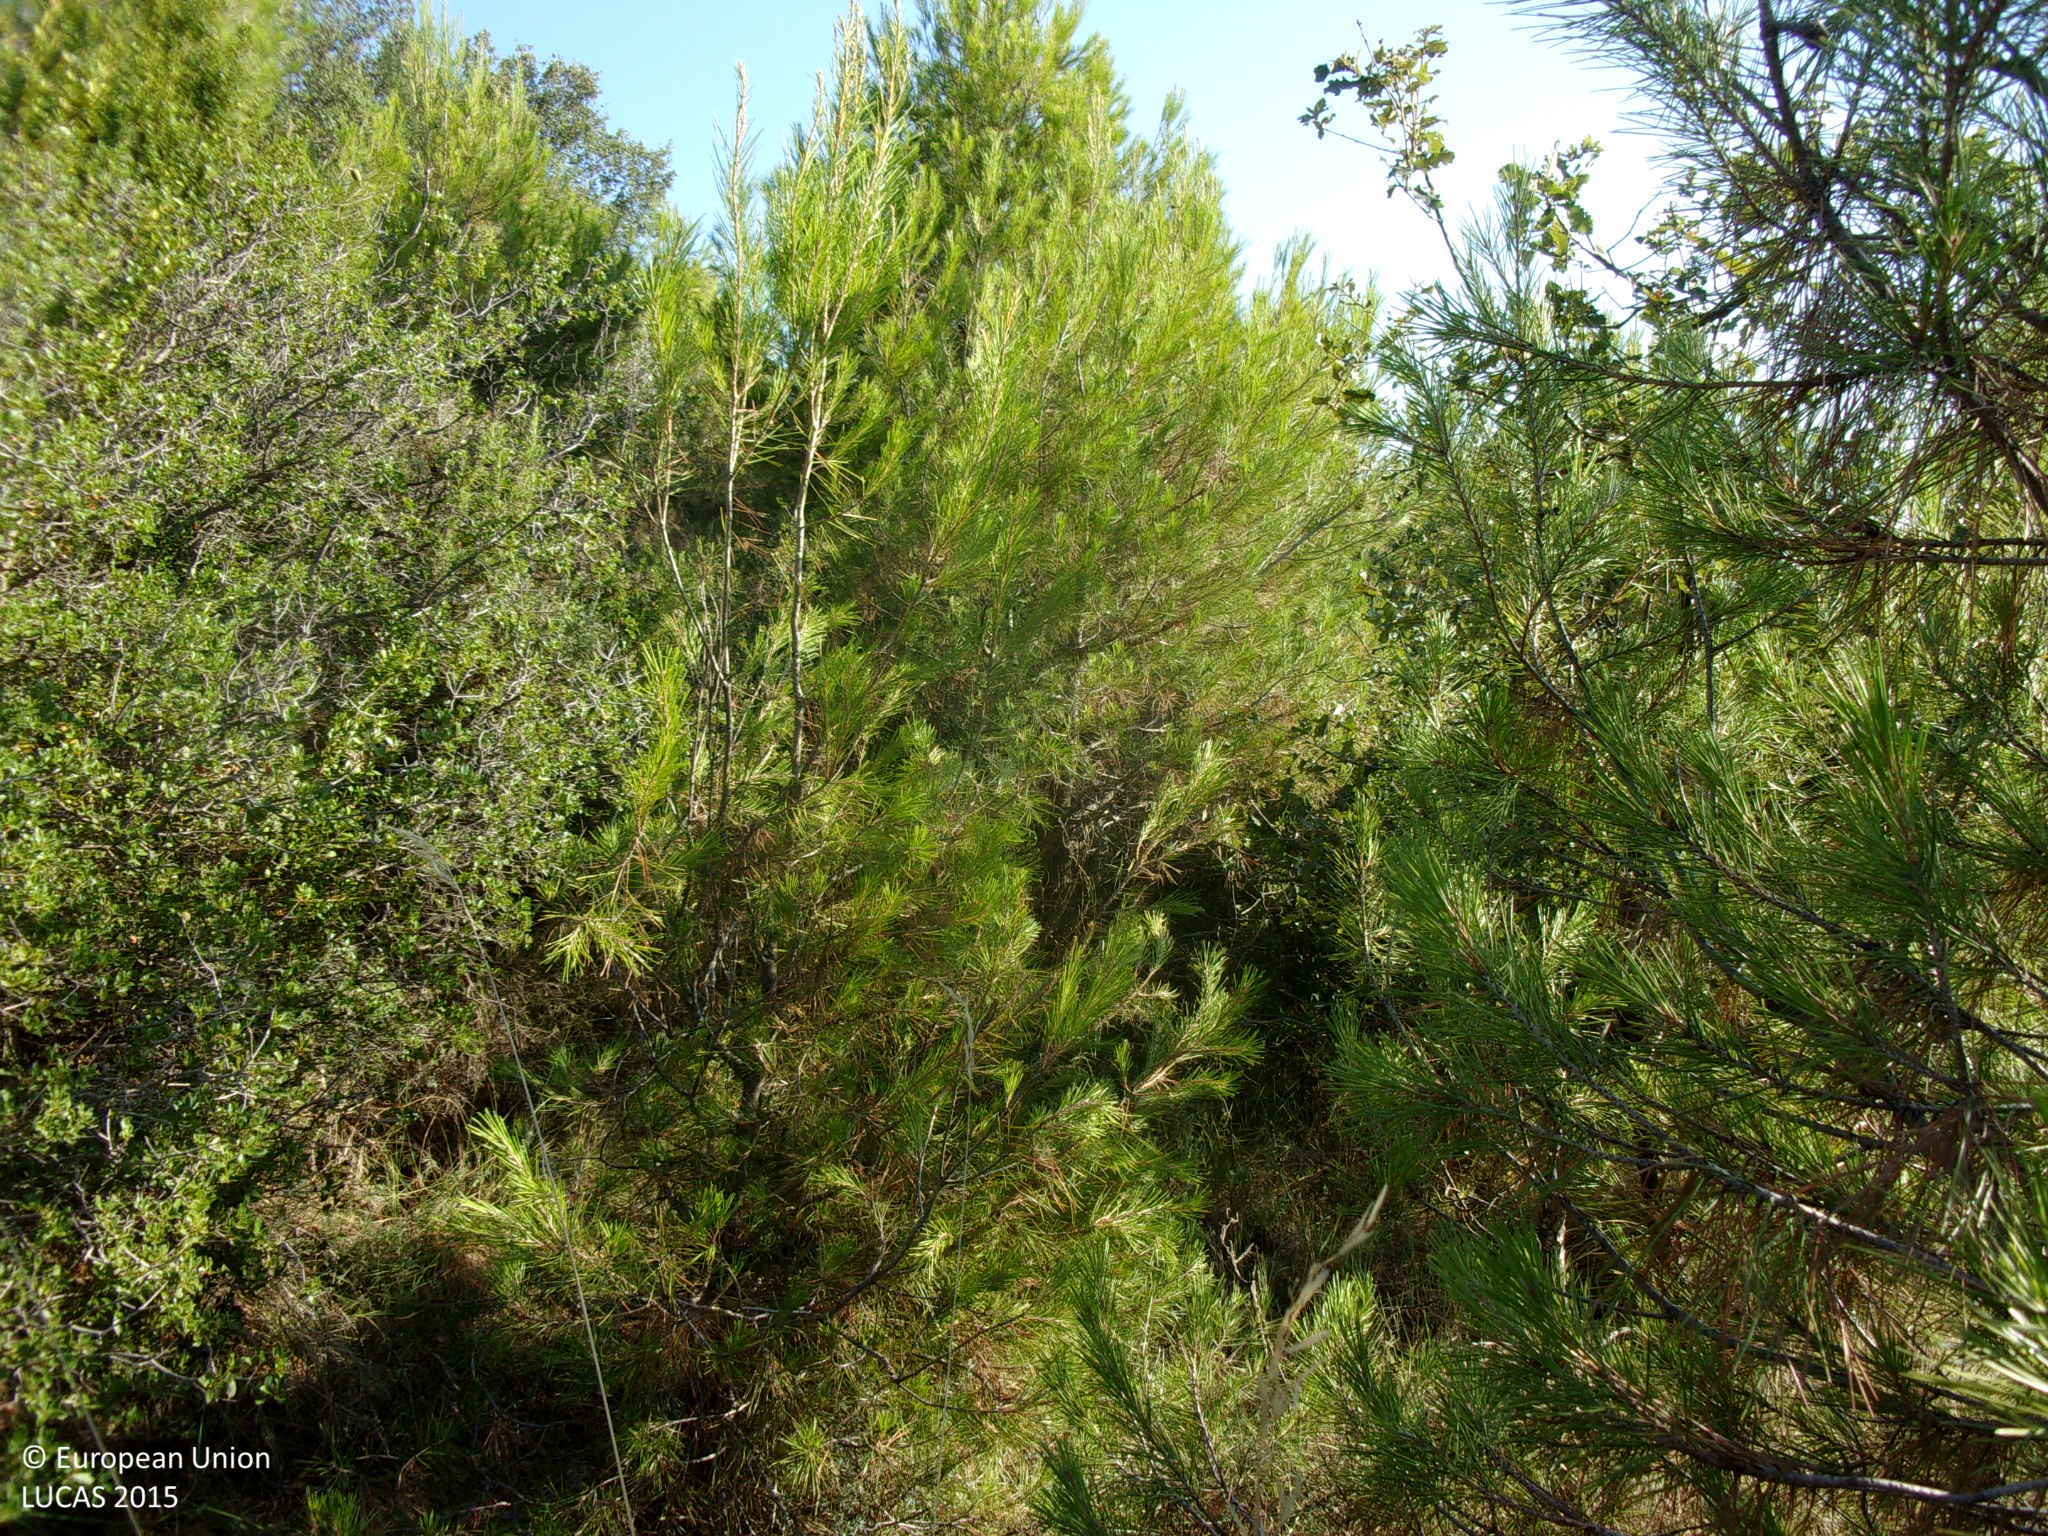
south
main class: Woodland
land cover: Pine dominated coniferous woodland
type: coniferous forest of the mediterranean region
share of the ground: 50 - 75 %
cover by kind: coniferous forest trees 60 %, shrubs 40 %
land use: Forestry
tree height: < 5 m
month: August
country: ES
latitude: 42.2284
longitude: -0.8953
